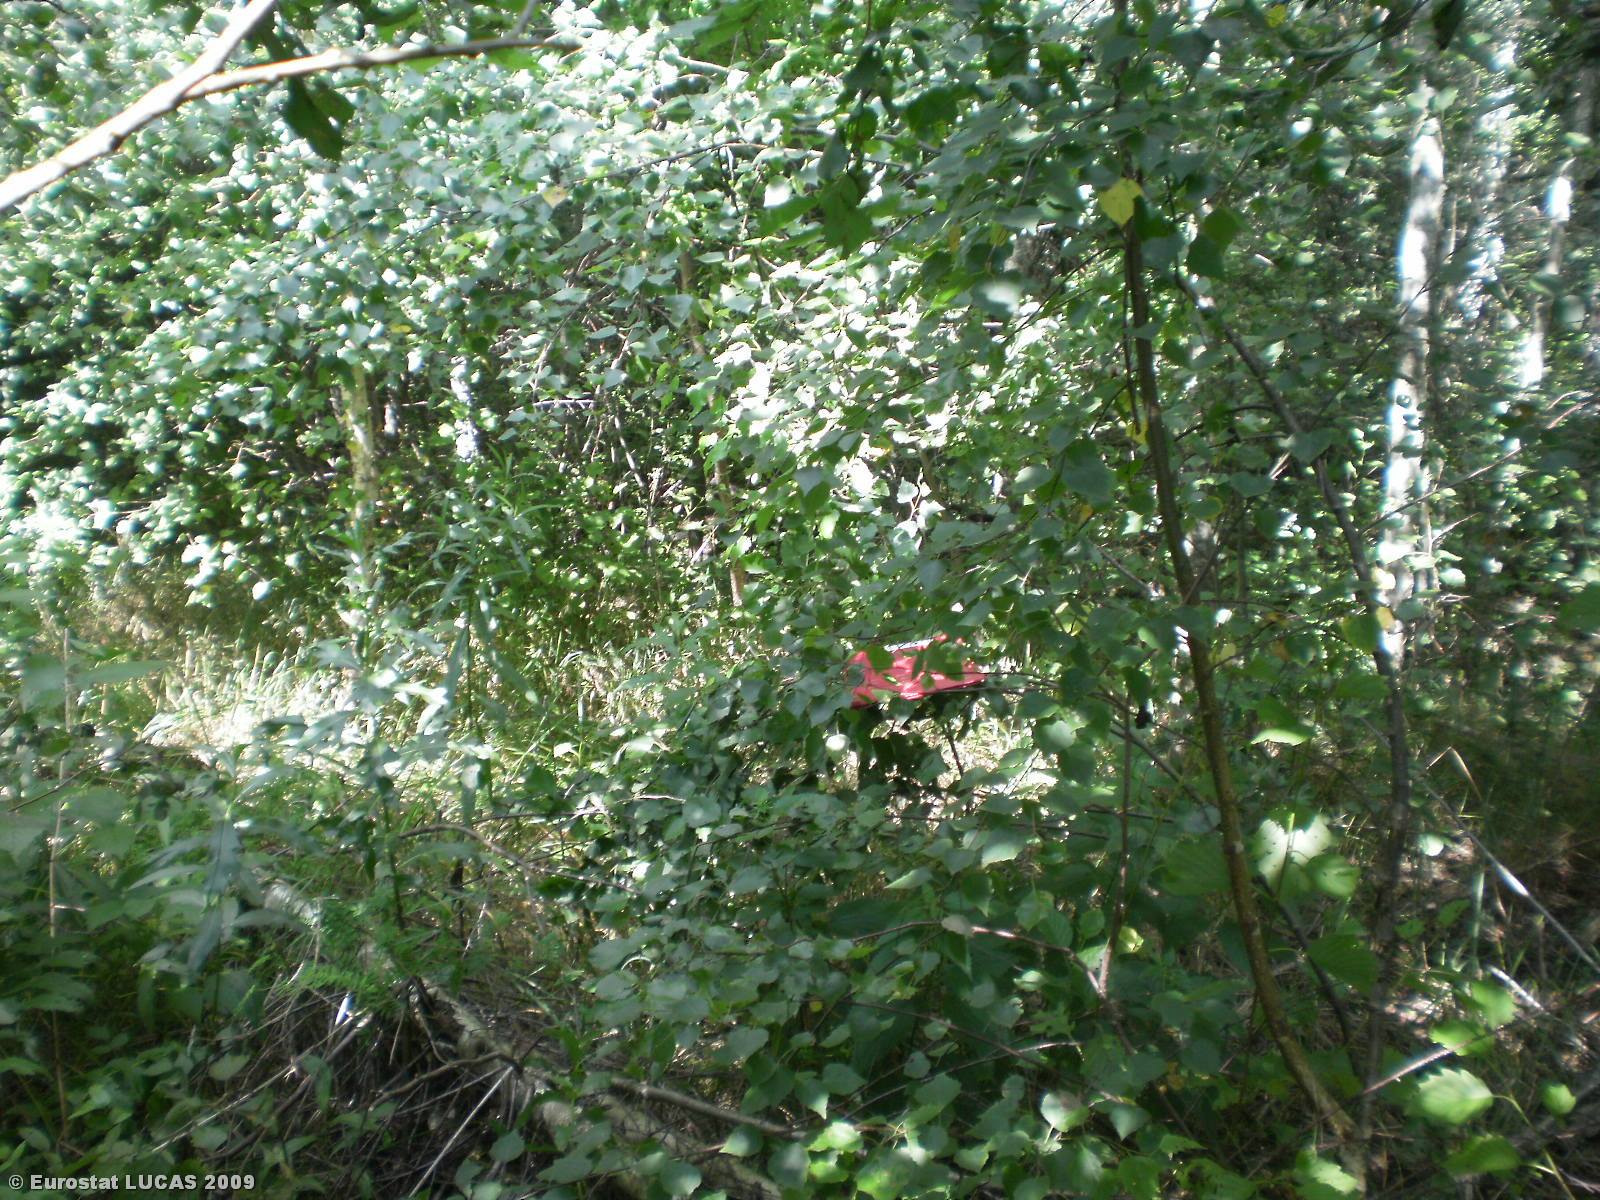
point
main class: Woodland
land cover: Broadleaved woodland
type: non-riverine alder, birch or aspen forest
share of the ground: > 75 %
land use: Forestry
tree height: > 5 m
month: July
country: LT
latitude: 56.1008
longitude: 25.3425
